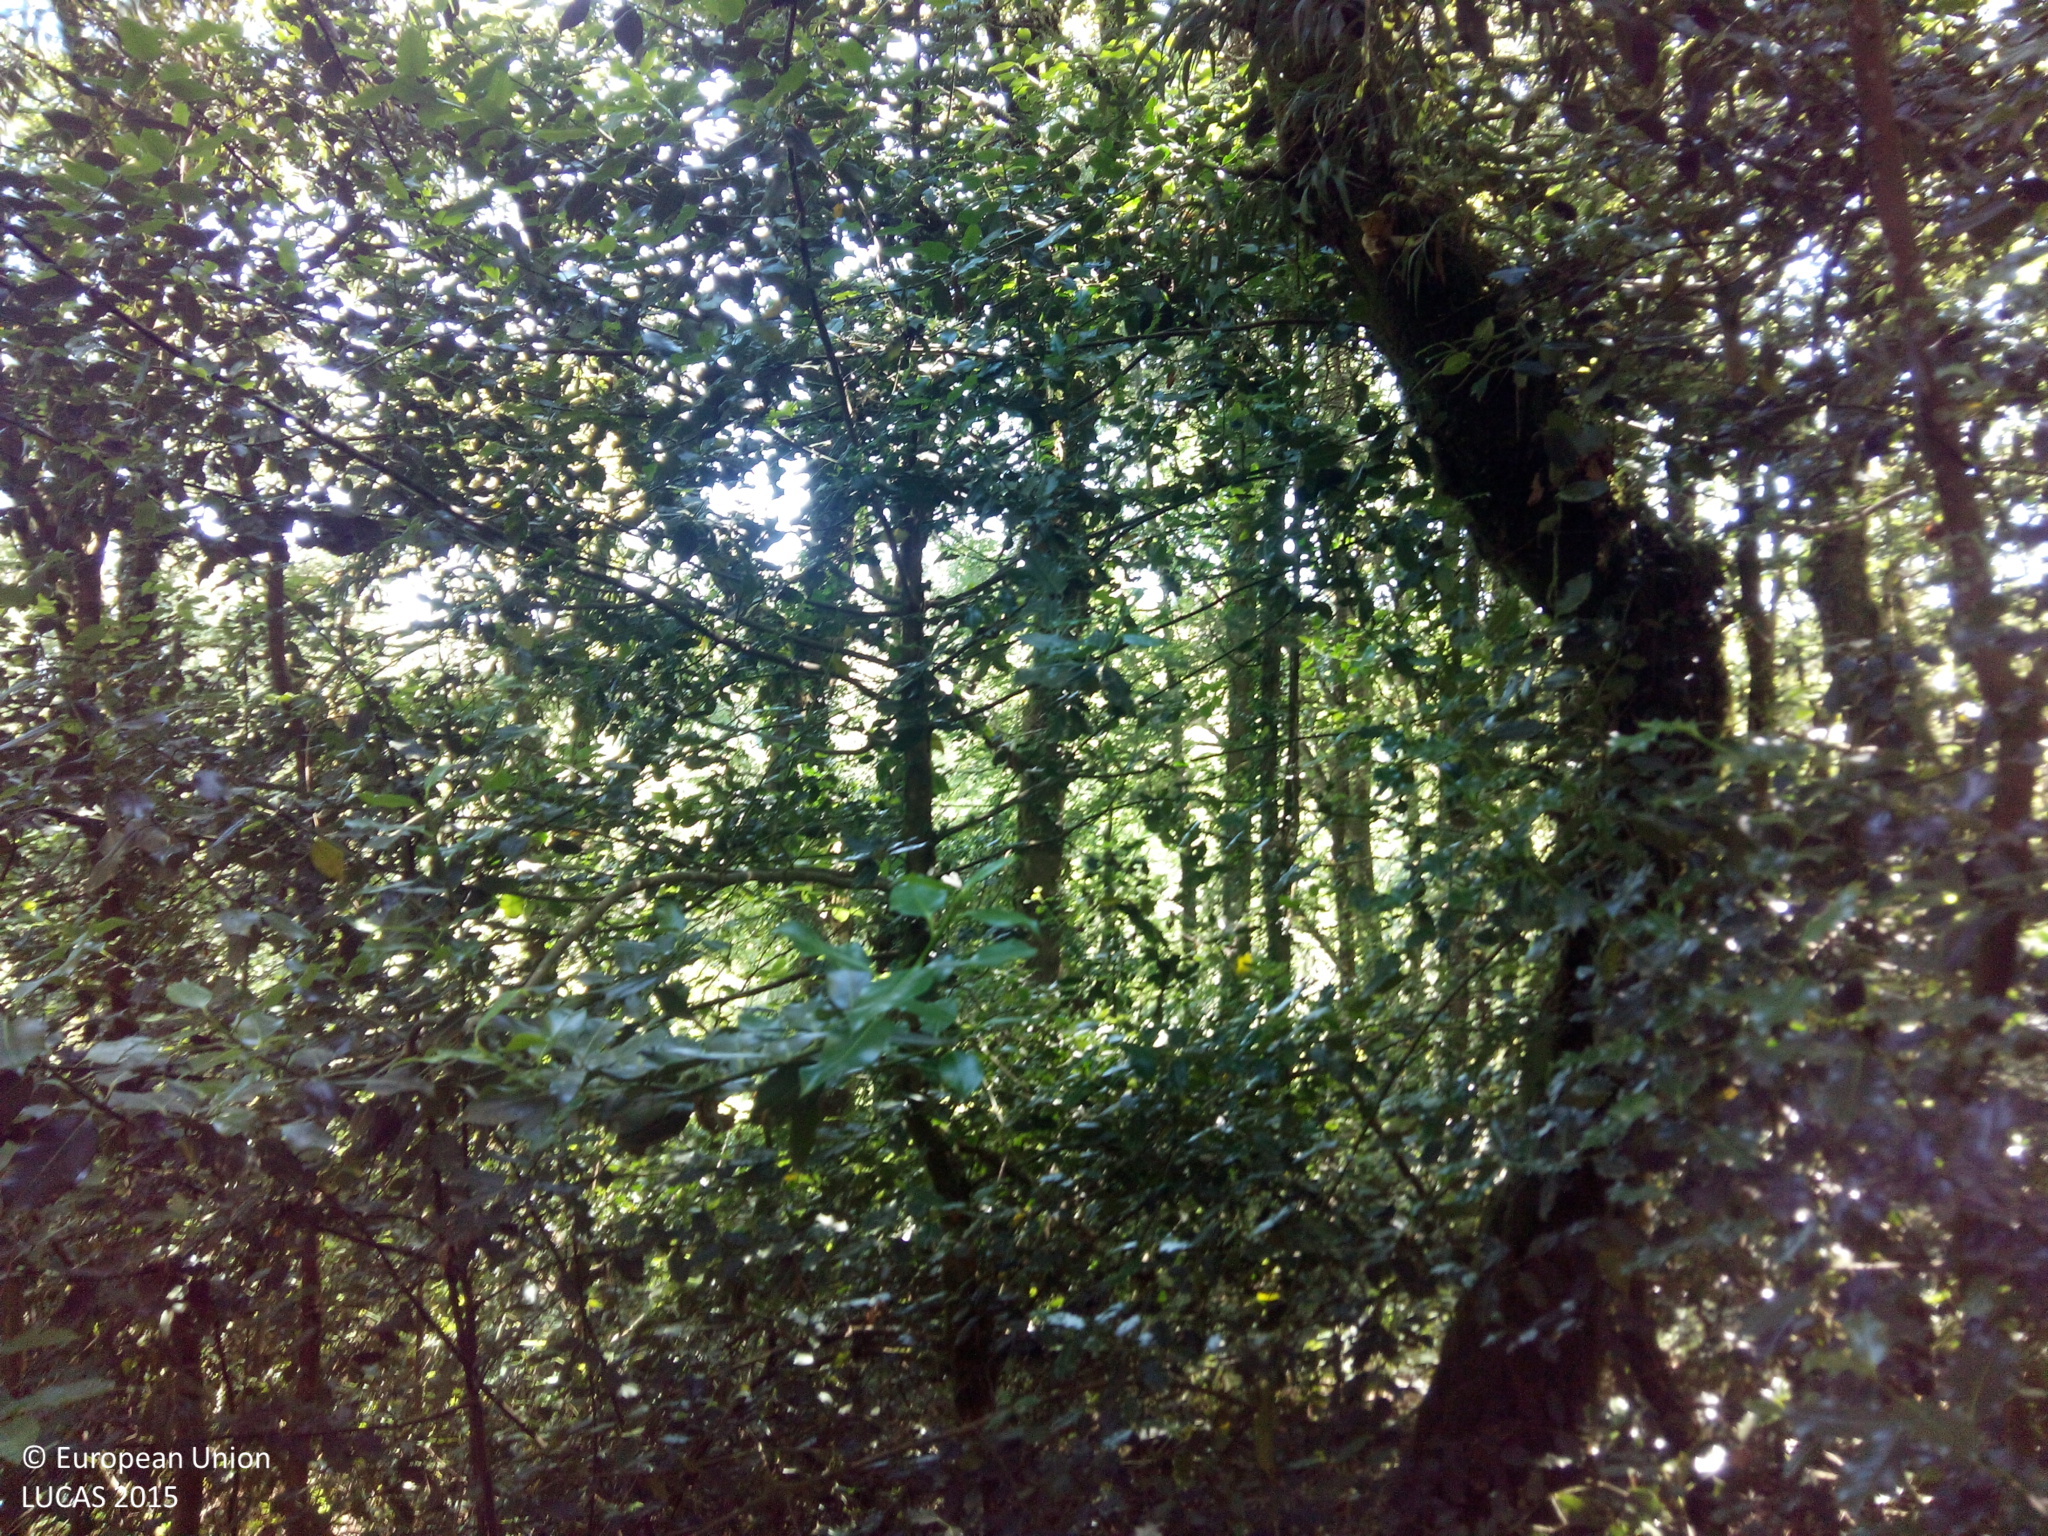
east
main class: Woodland
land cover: Broadleaved woodland
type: acidophilous oak and oak-birch forest
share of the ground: > 75 %
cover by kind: broadleaved forest trees 100 %
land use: Forestry
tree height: > 5 m
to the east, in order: Broadleaved woodland; Dry stone walls; Broadleaved woodland; Shrubland without tree cover; Broadleaved woodland; Ditches and canals; Grassland with sparse tree/shrub cover; Groves; Rivers and streams; Grassland with sparse tree/shrub cover; Fences; Broadleaved woodland
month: June
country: ES
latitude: 42.5186
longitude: -8.3145
